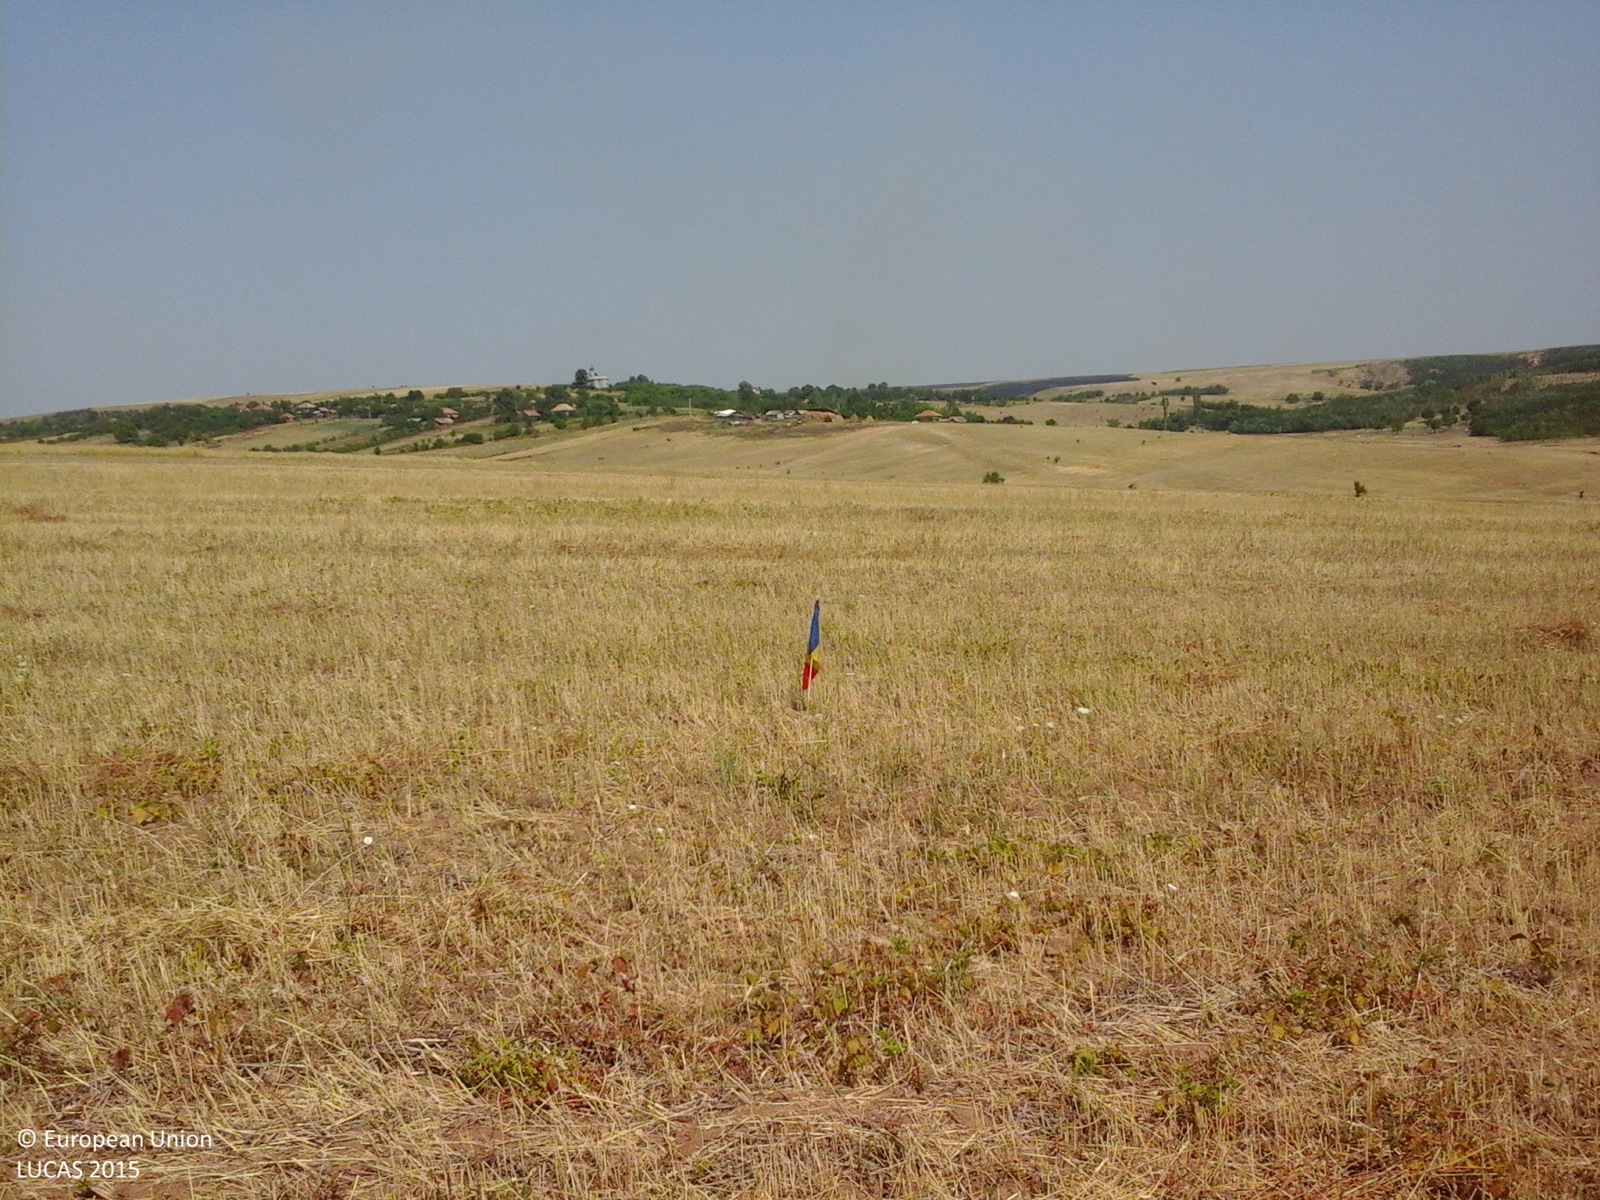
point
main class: Cropland
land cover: Durum wheat
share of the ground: > 75 %
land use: Agriculture (excluding fallow land and kitchen gardens)
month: August
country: RO
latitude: 44.4268
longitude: 22.9700
